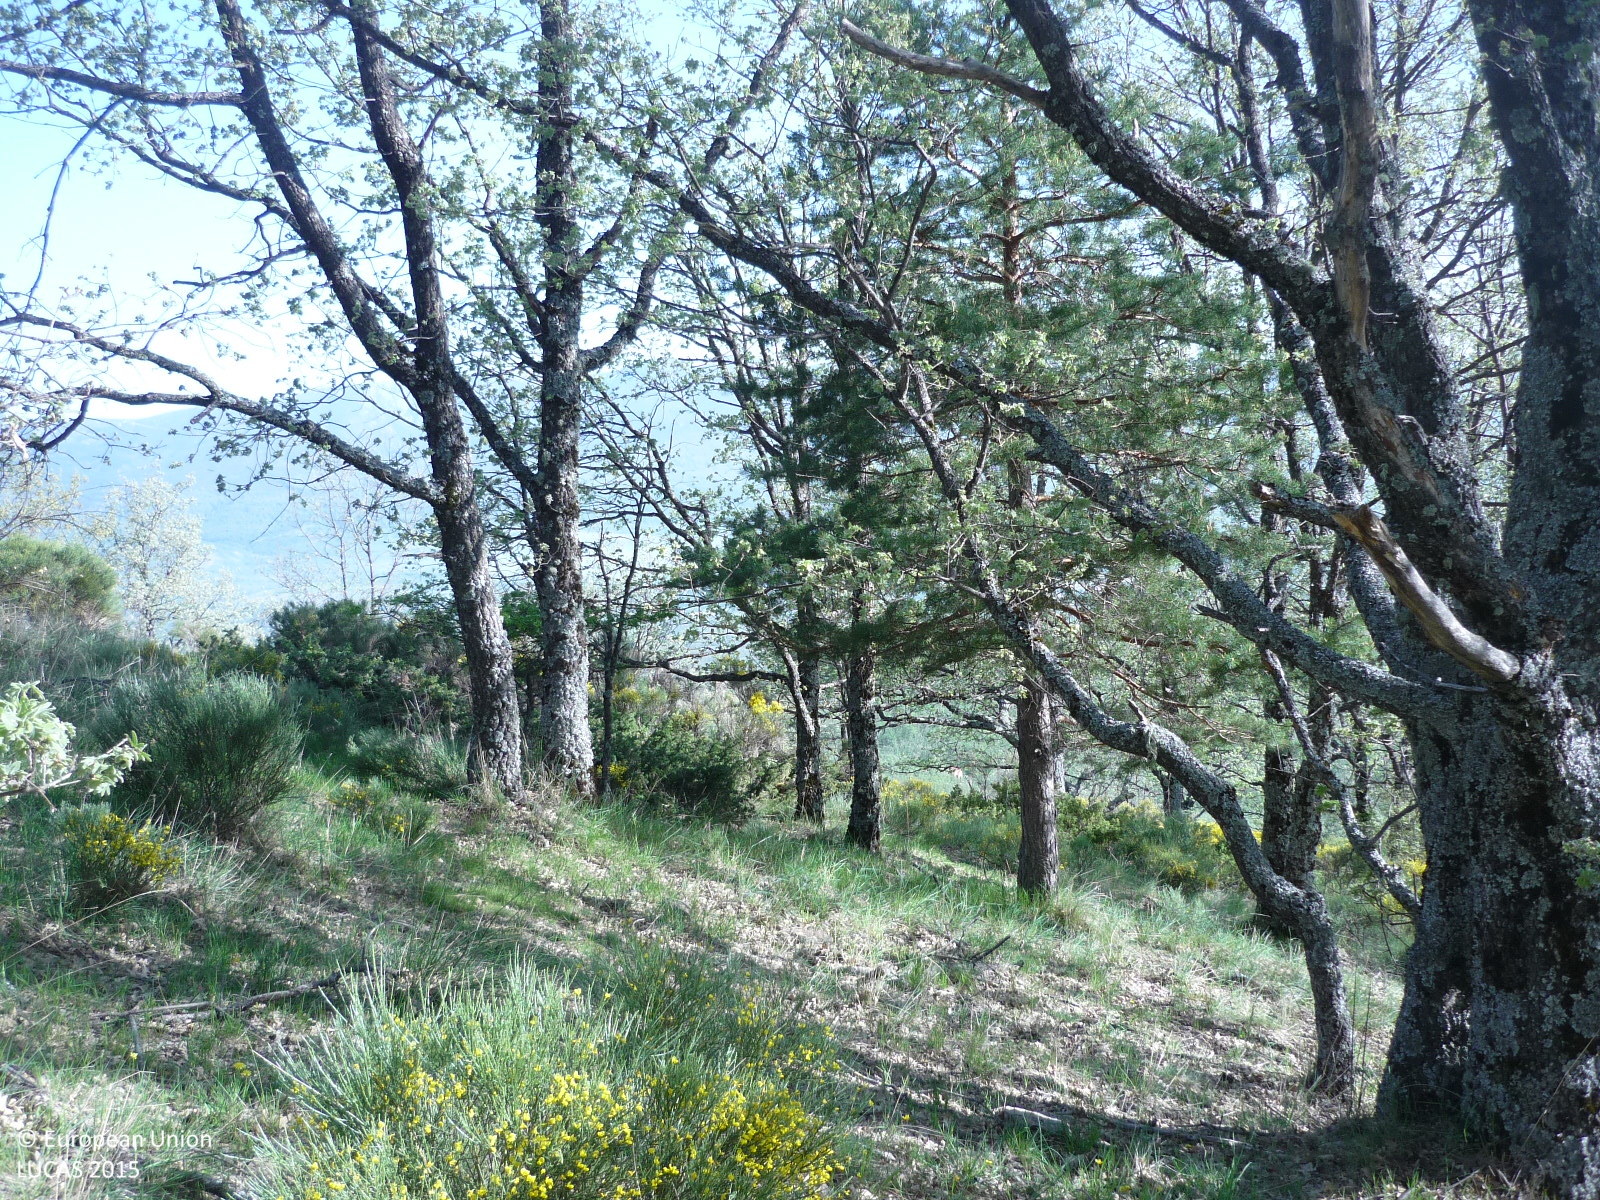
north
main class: Woodland
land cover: Broadleaved woodland
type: thermophilous deciduous forest
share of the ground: > 75 %
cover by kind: broadleaved forest trees 85 %, shrubs 10 %, herbaceous plants 5 %
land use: Semi-natural and natural areas not in use
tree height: > 5 m
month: May
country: ES
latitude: 40.8743
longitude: -3.8455
